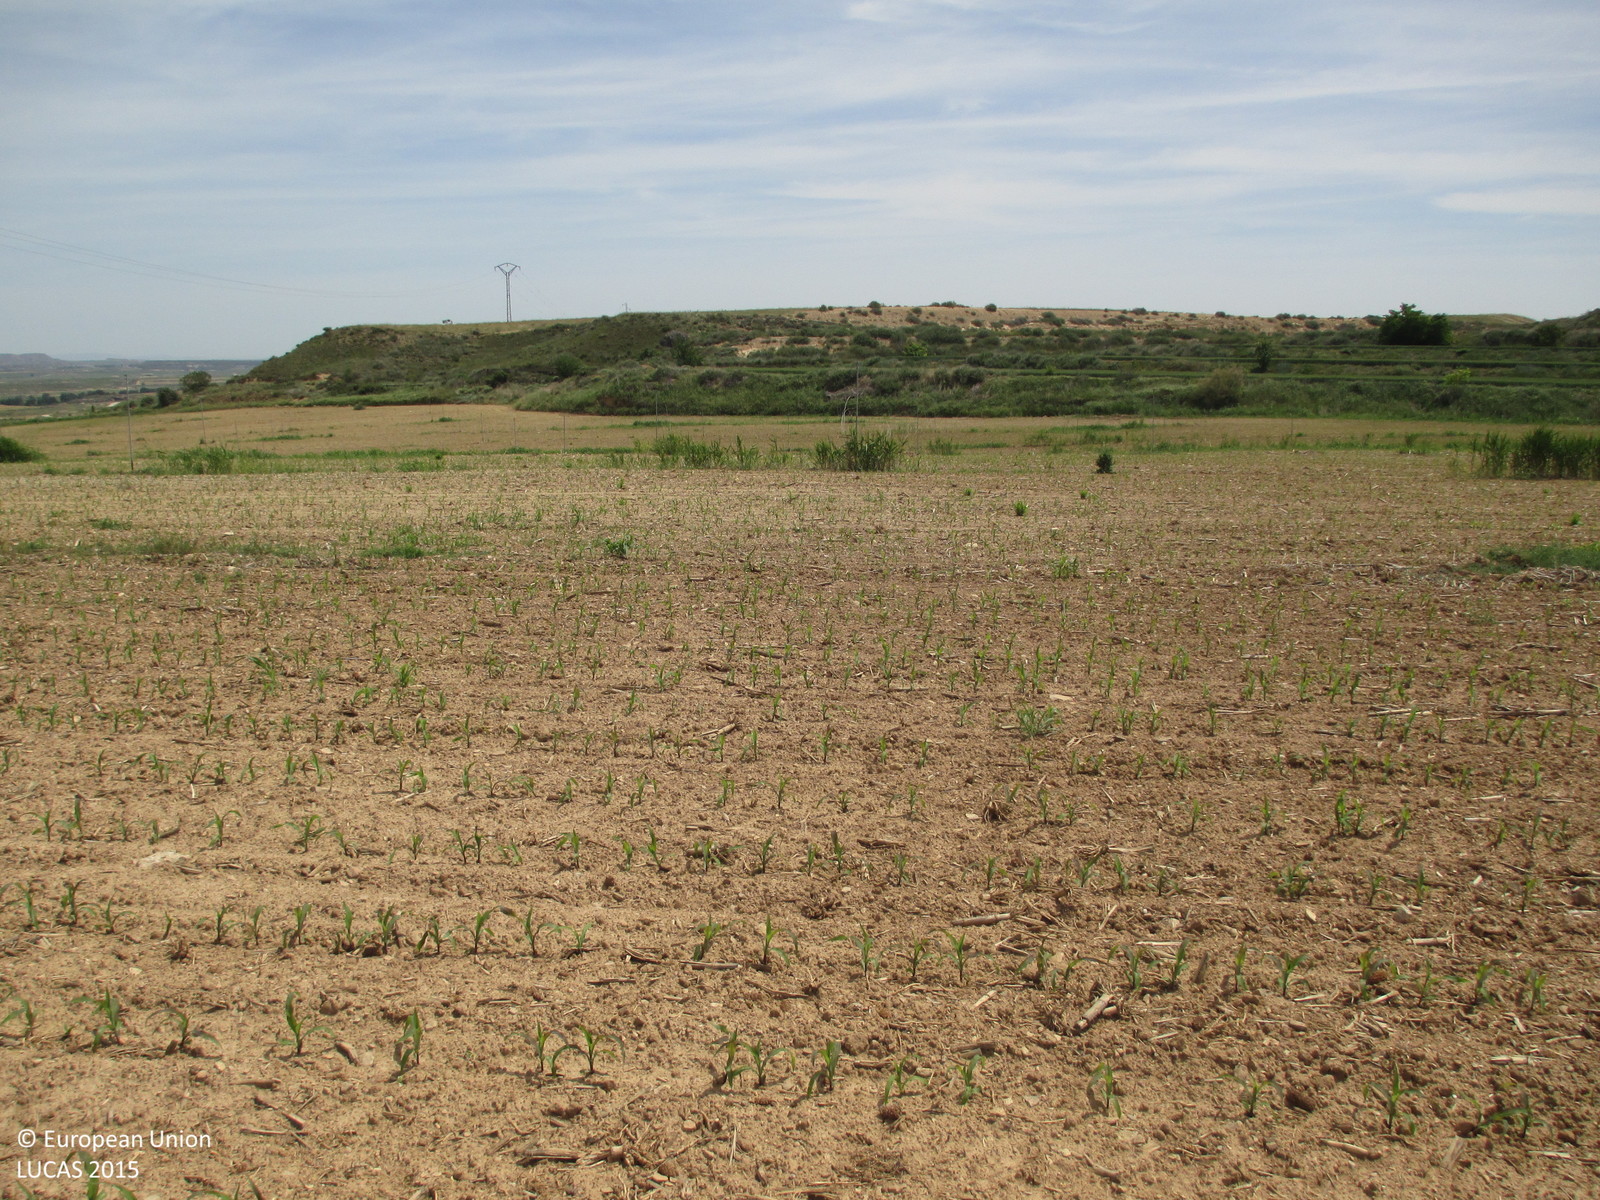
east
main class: Cropland
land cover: Maize
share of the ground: < 10 %
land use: Agriculture (excluding fallow land and kitchen gardens)
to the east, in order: Maize; Shrubland with sparse tree cover; Ditches and canals; Shrubland without tree cover; Spontaneously vegetated surfaces
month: May
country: ES
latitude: 41.8682
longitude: -0.3449
